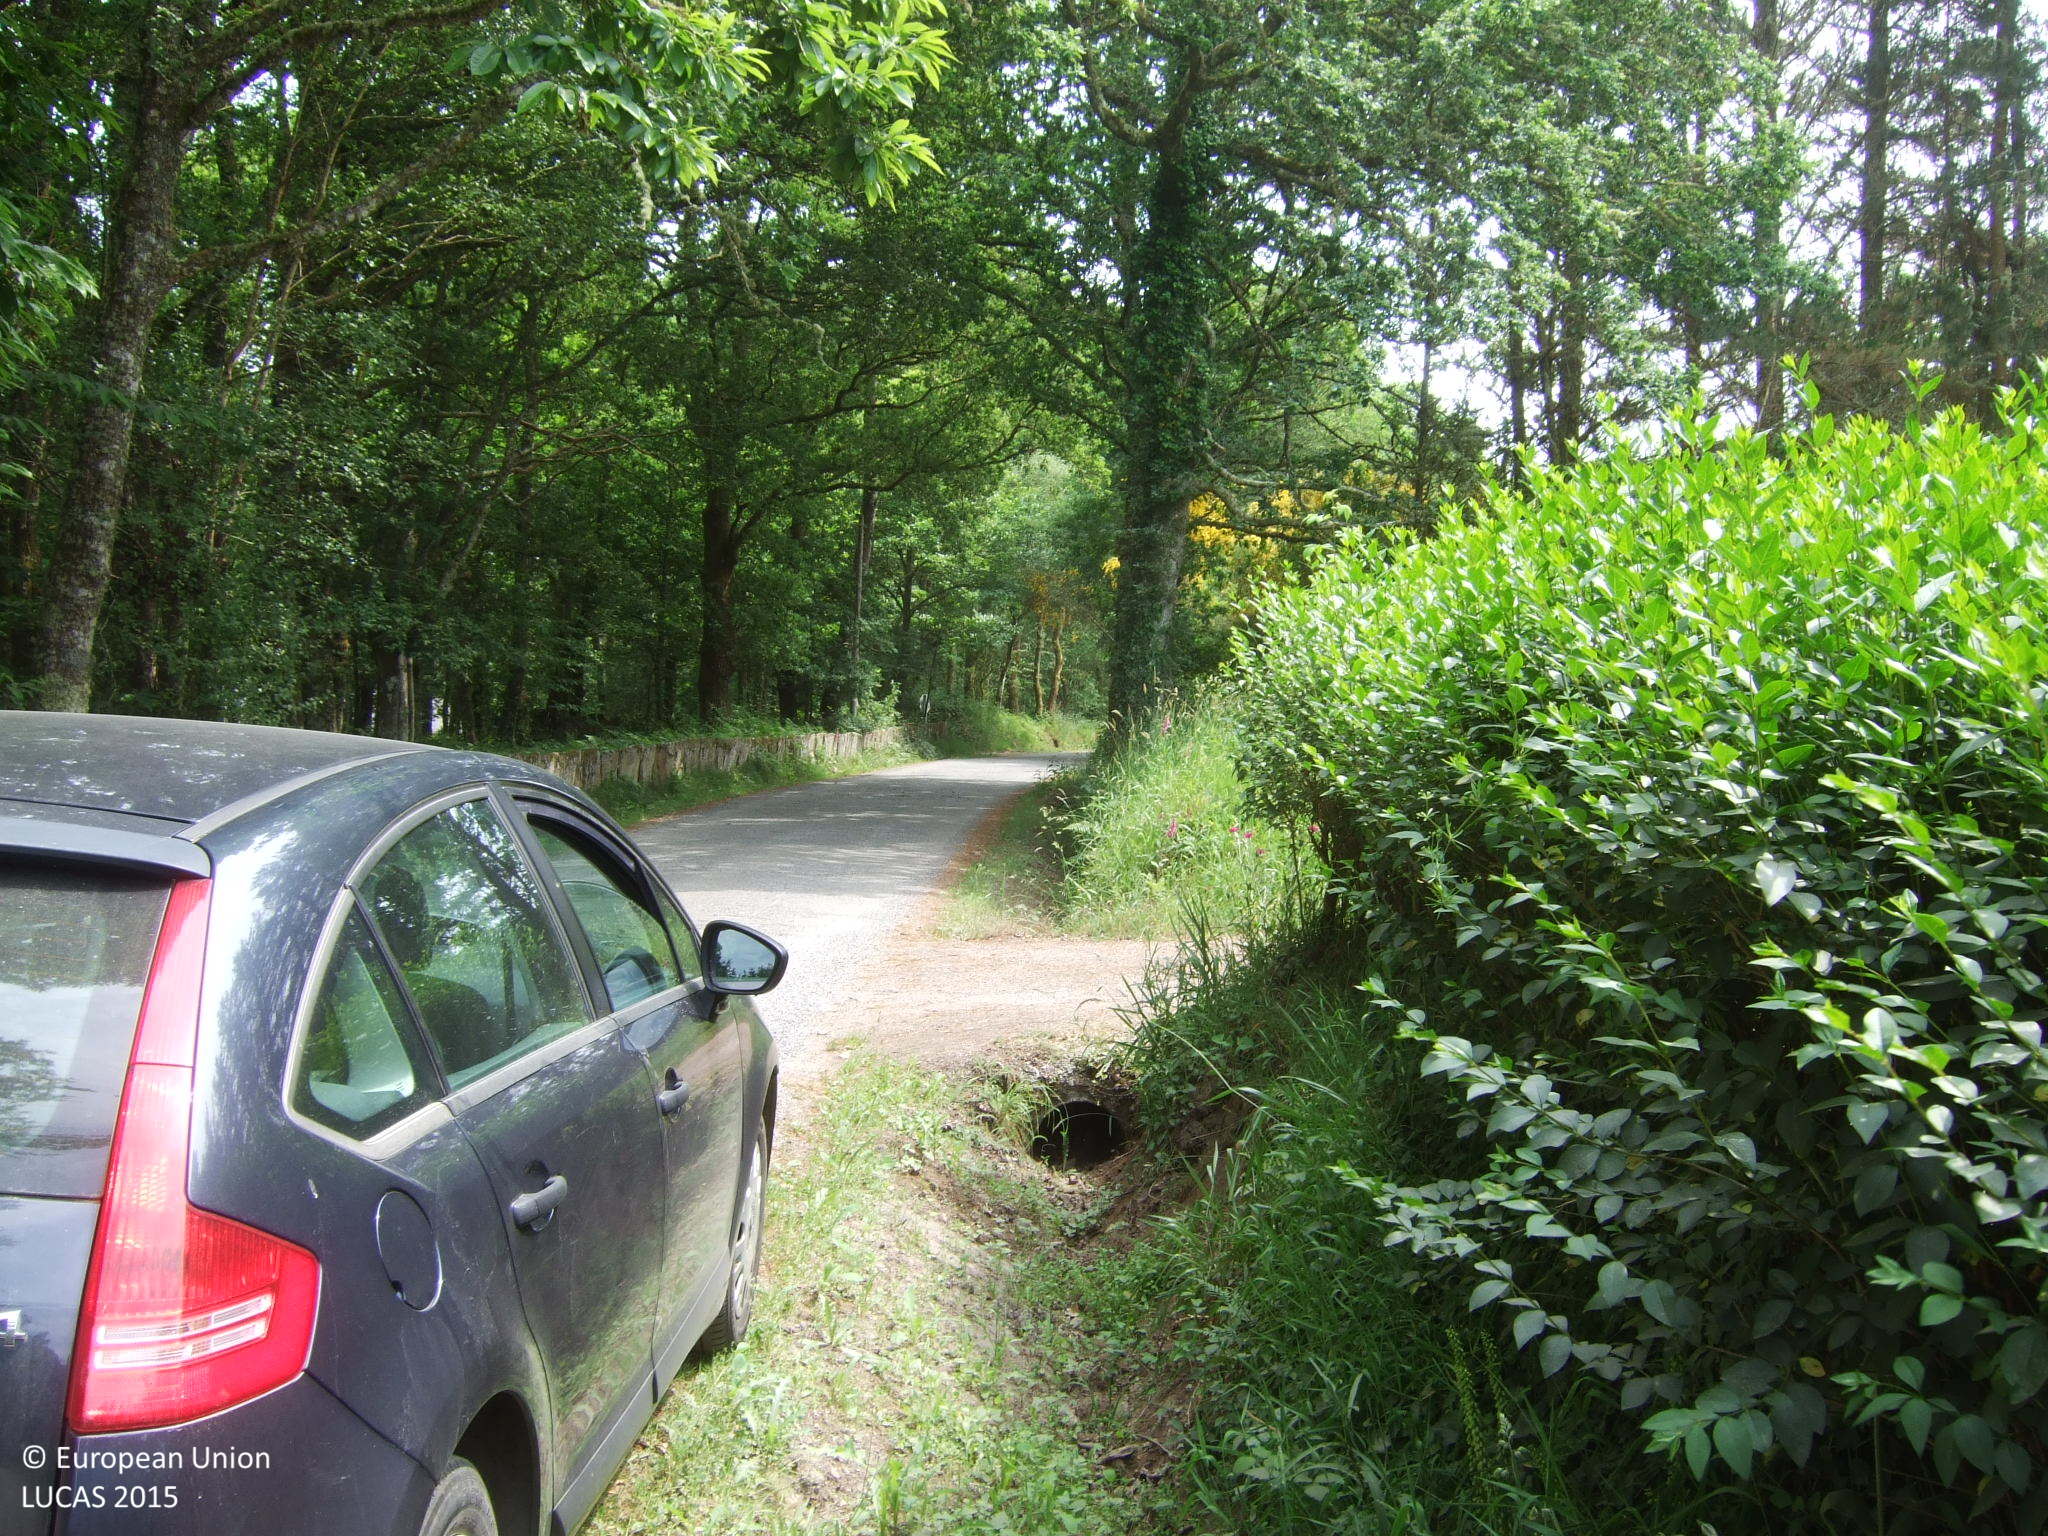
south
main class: Cropland
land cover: Apple fruit
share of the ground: 10 - 25 %
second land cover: Grassland without tree/shrub cover
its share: > 75 %
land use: Kitchen garden
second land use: Residential
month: June
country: ES
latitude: 43.3329
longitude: -7.6847
